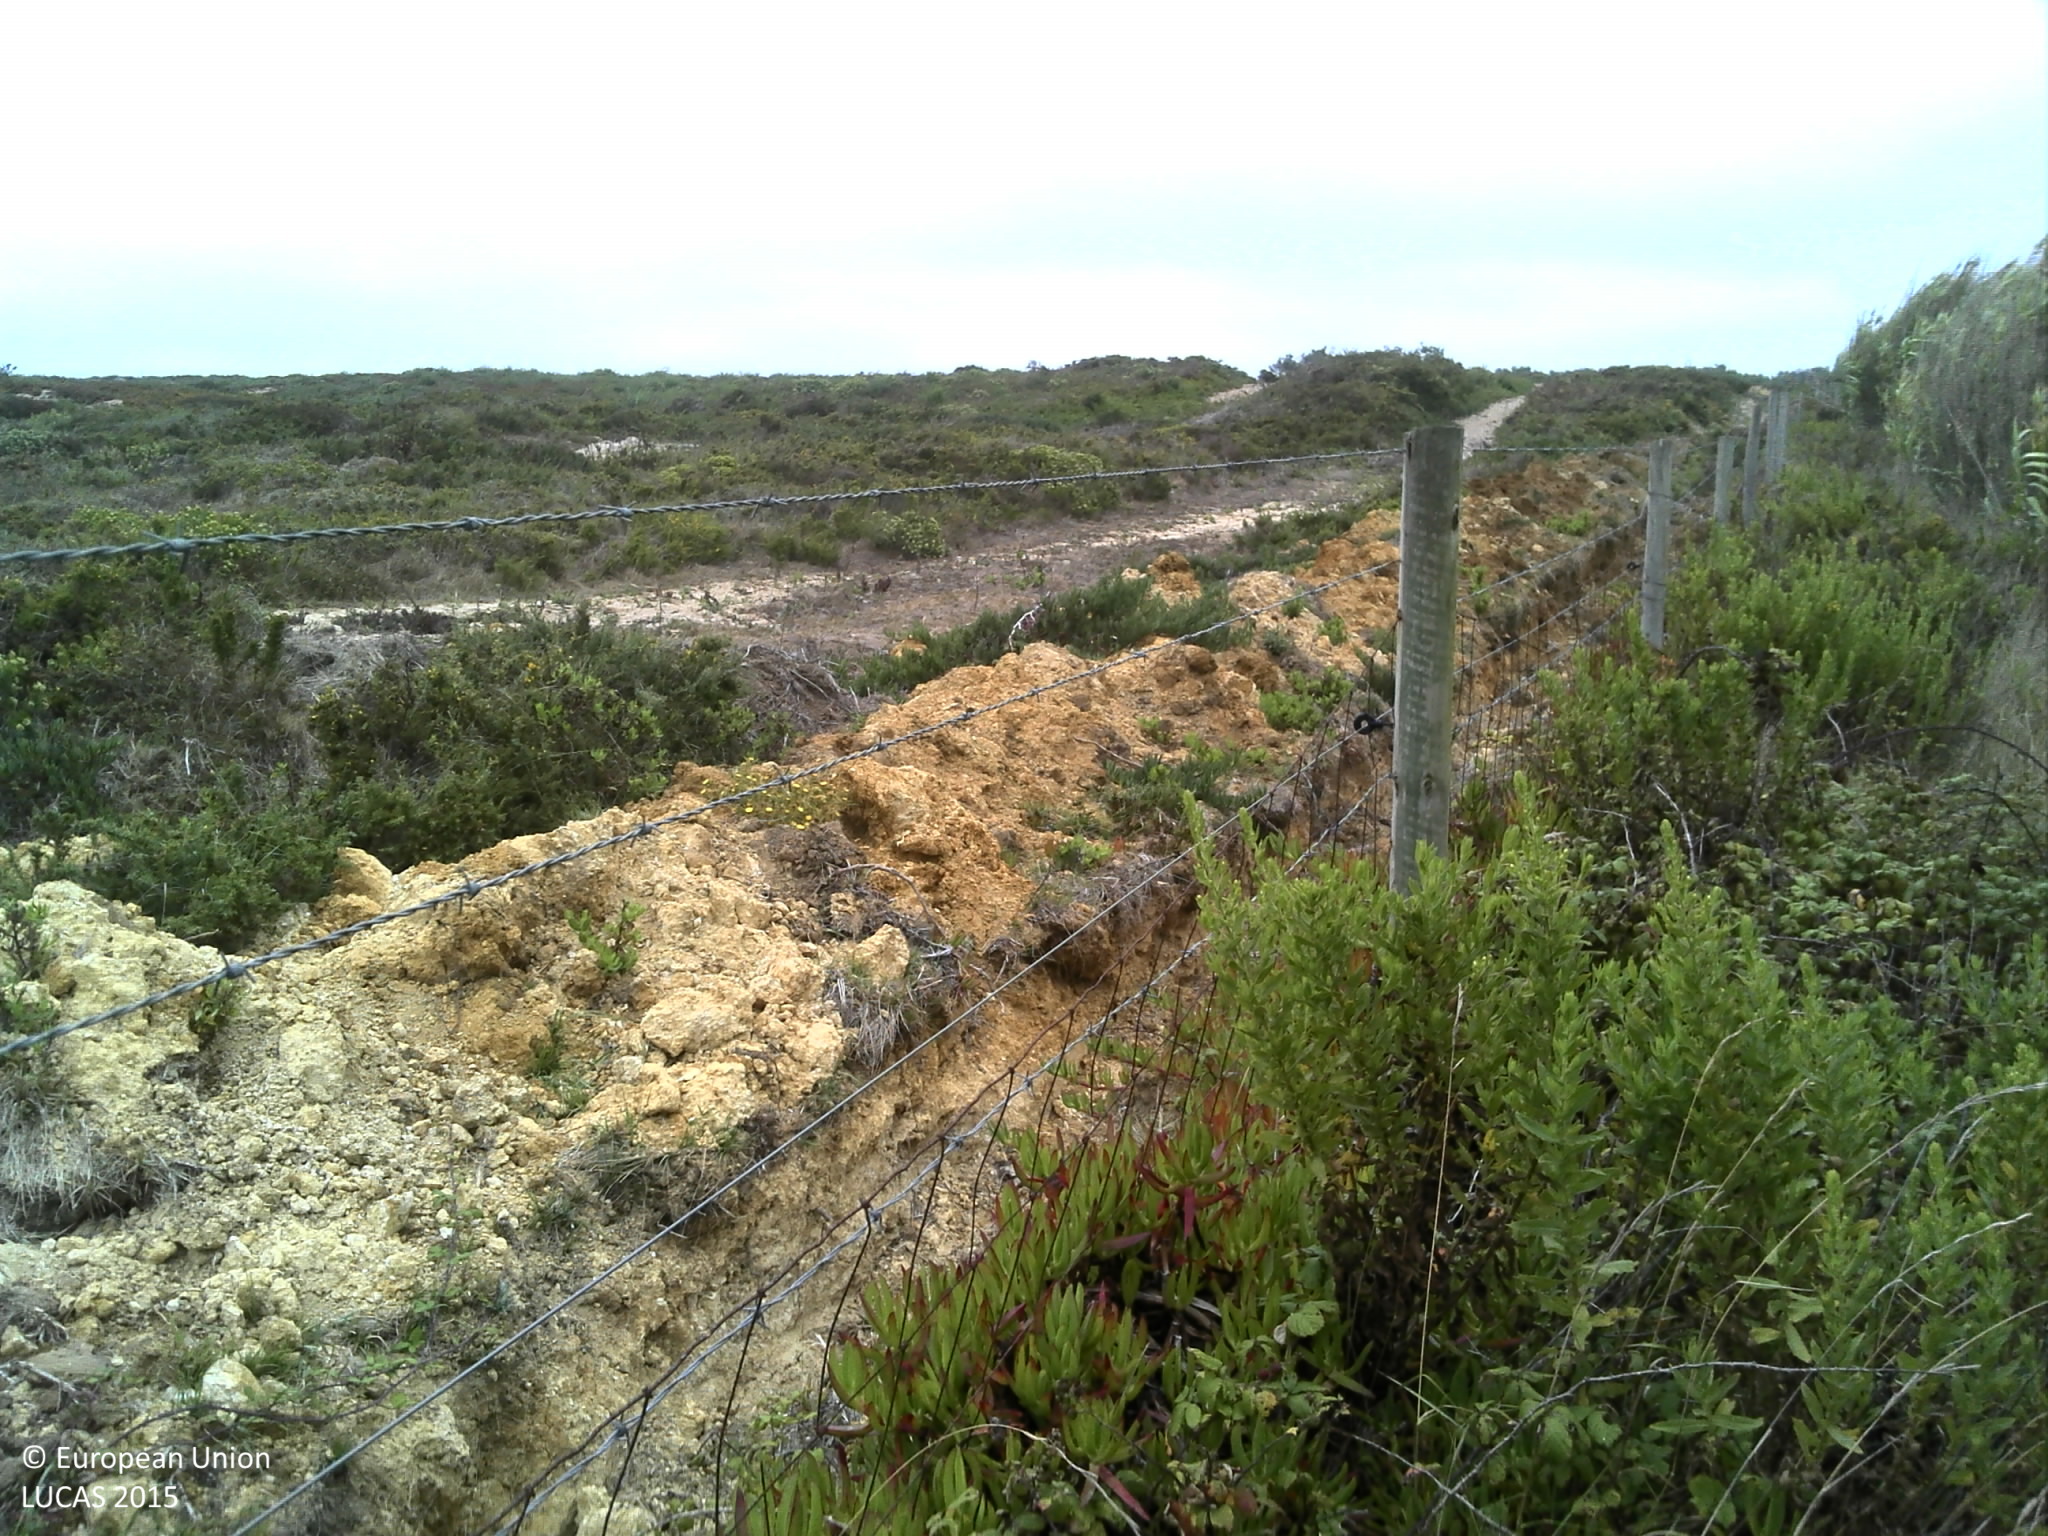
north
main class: Shrubland
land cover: Shrubland without tree cover
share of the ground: > 75 %
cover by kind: shrubs 90 %, unconsolidated bare surface 10 %
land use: Semi-natural and natural areas not in use
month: August
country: PT
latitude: 38.8764
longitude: -9.4405
